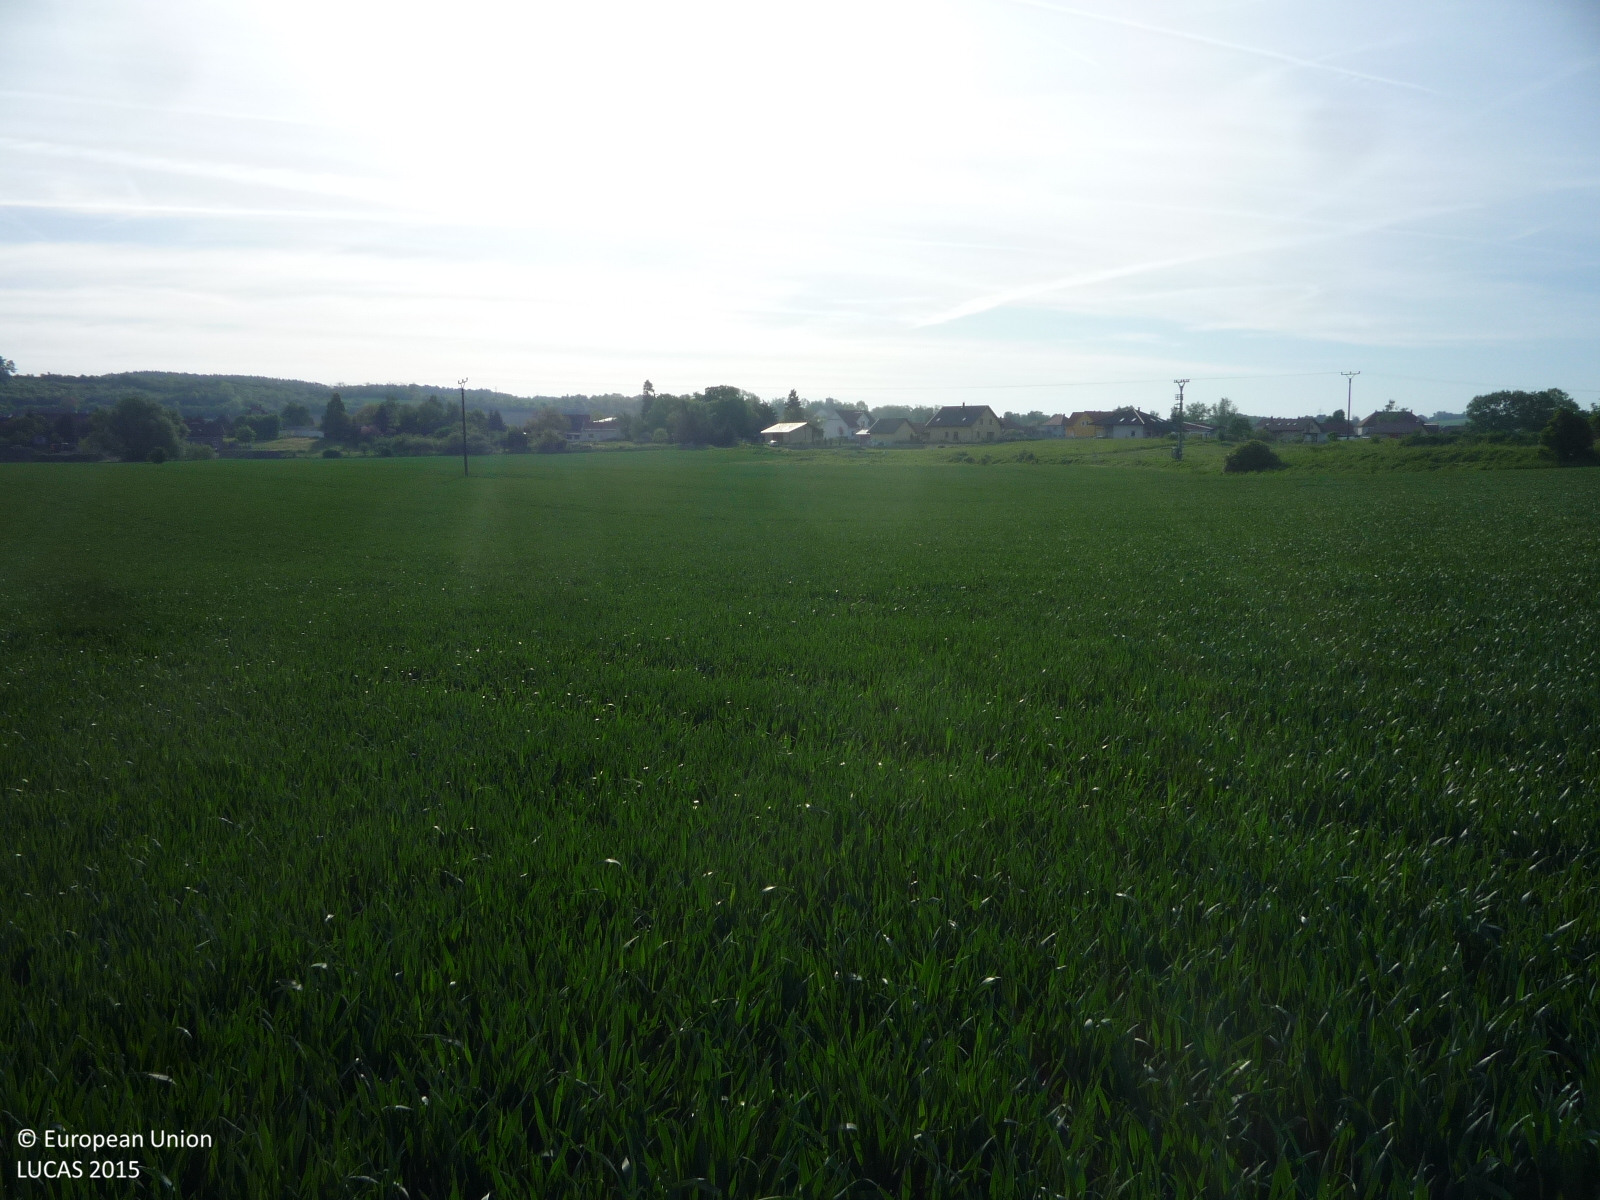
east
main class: Cropland
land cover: Common wheat
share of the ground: > 75 %
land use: Agriculture (excluding fallow land and kitchen gardens)
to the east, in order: Common wheat; Electric lines; Common wheat; Electric lines; Common wheat
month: May
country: CZ
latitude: 50.3112
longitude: 14.5093
